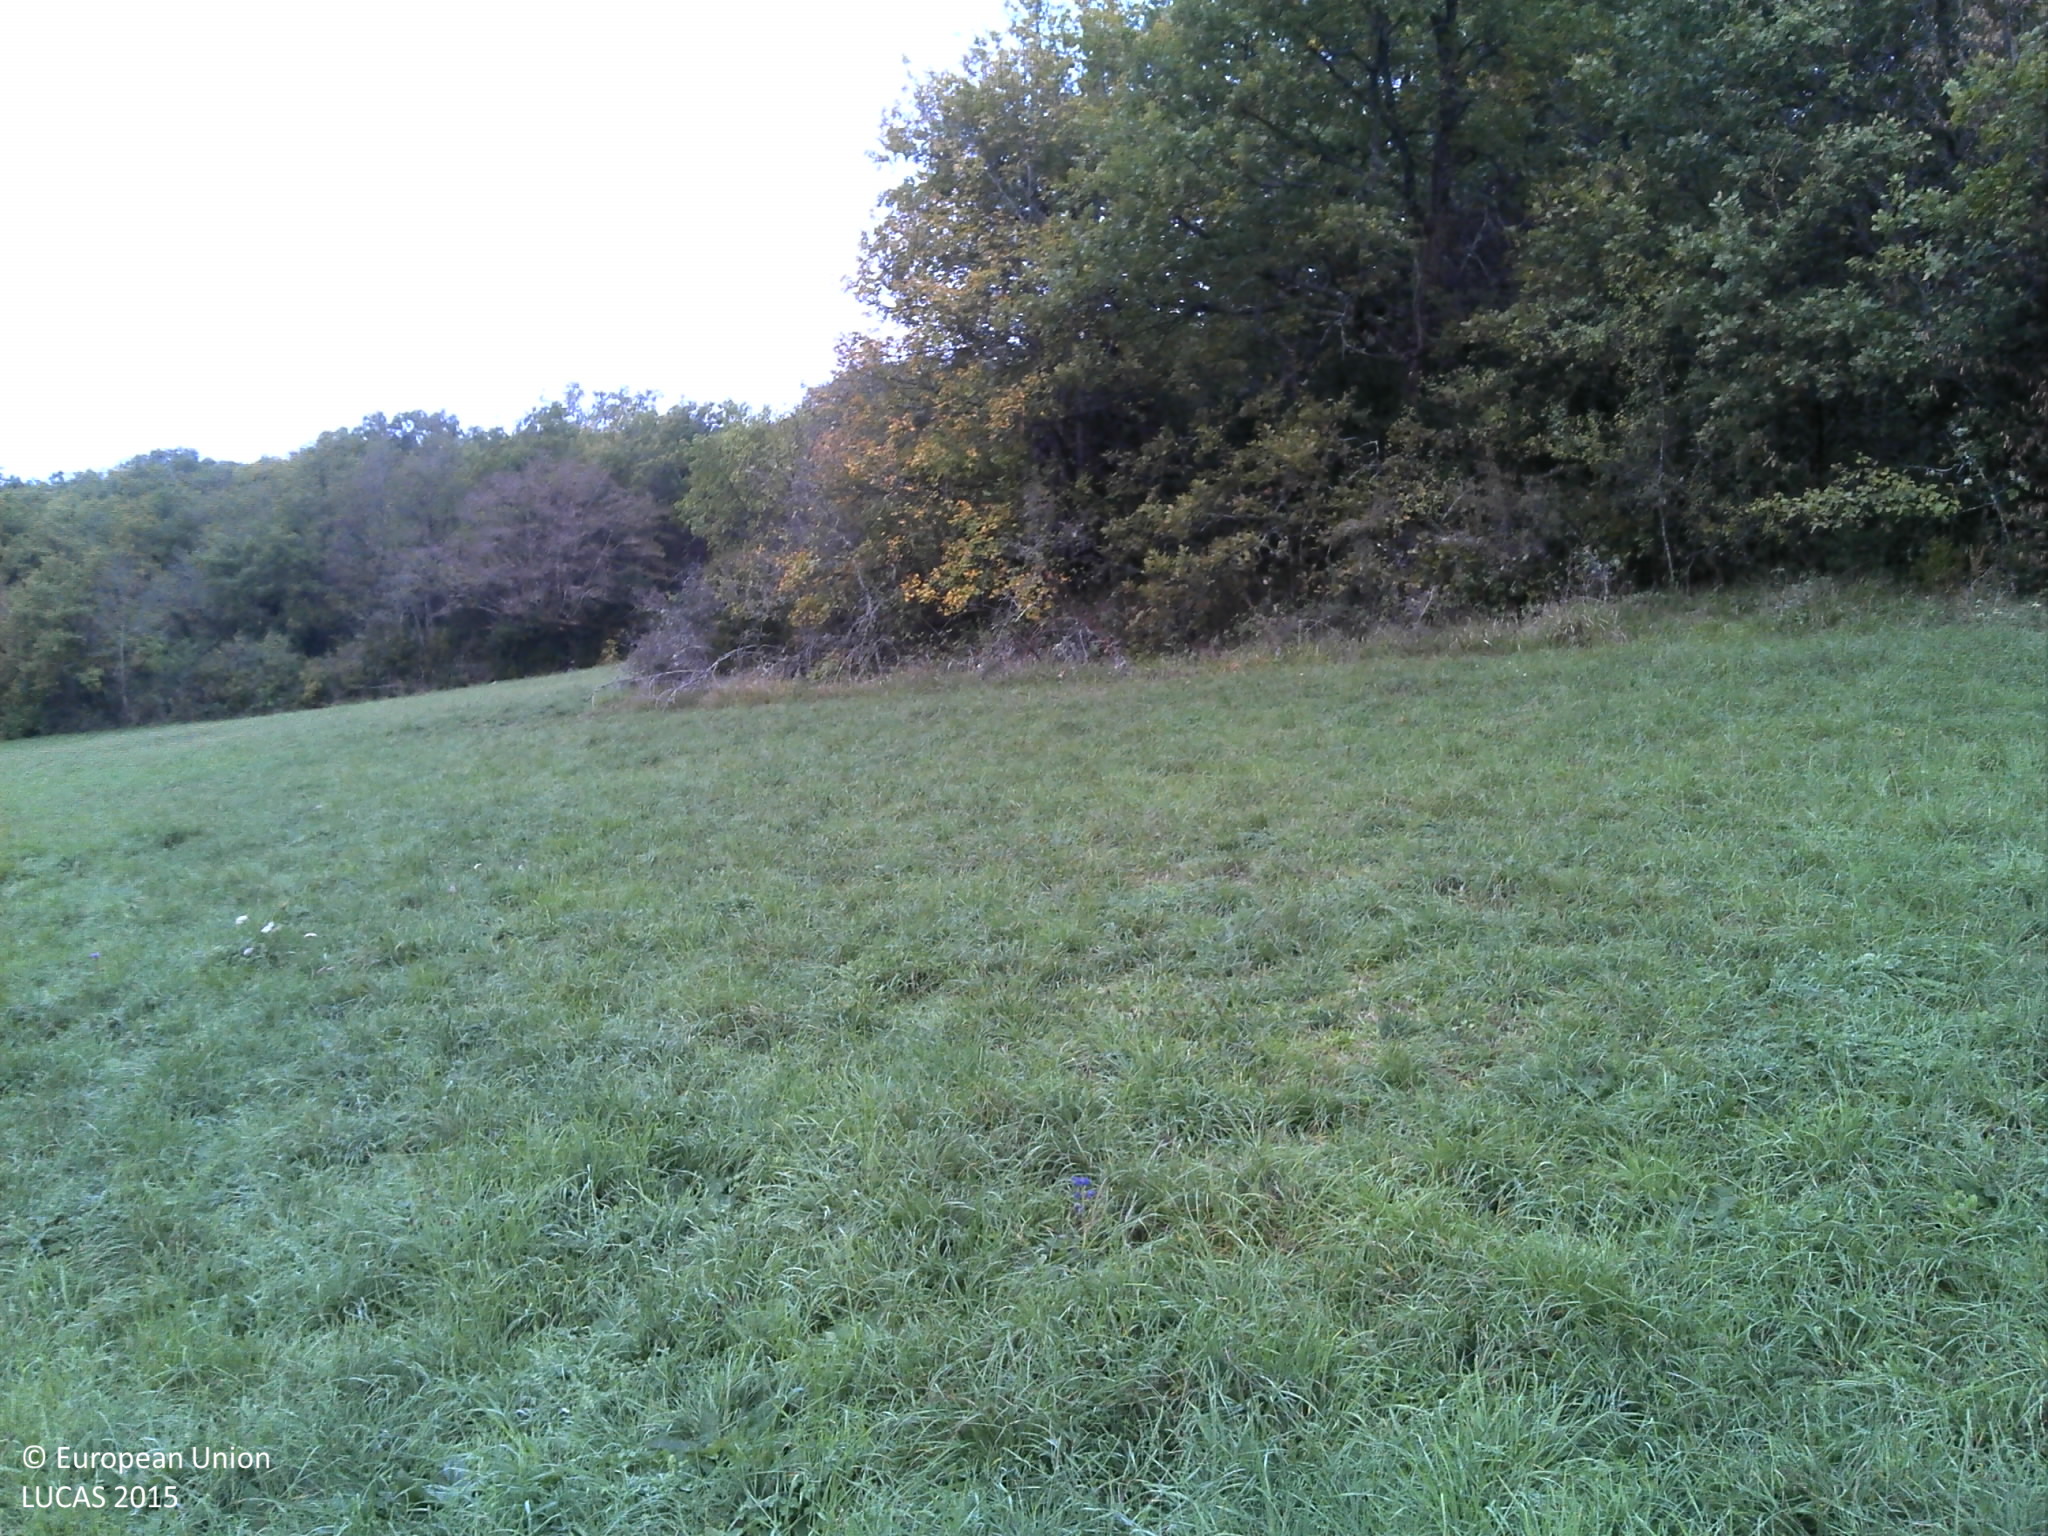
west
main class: Grassland
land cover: Grassland without tree/shrub cover
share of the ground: > 75 %
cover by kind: herbaceous plants 100 %
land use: Agriculture (excluding fallow land and kitchen gardens)
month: October
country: FR
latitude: 46.1242
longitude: 5.3573
